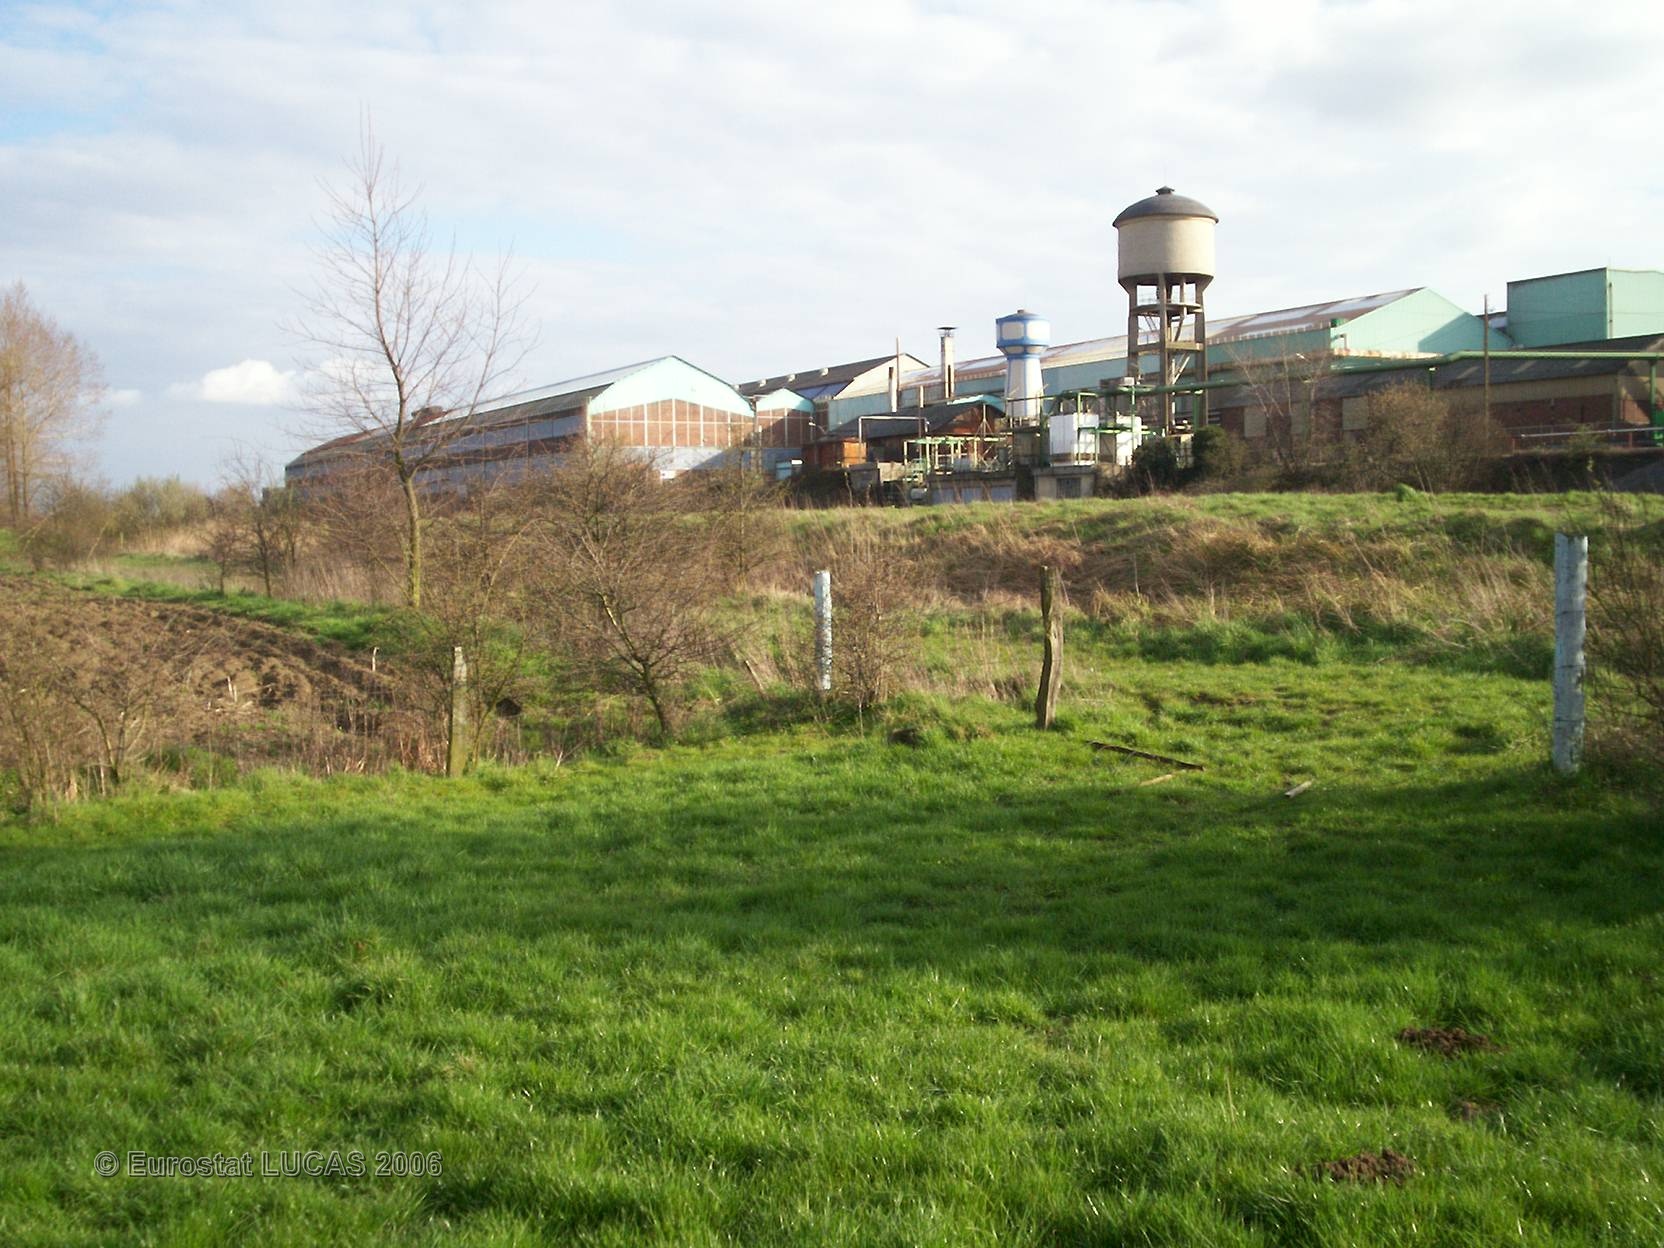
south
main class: Grassland
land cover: Grassland without tree/shrub cover
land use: Agriculture (excluding fallow land and kitchen gardens)
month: April
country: FR
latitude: 50.6221
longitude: 2.4816
